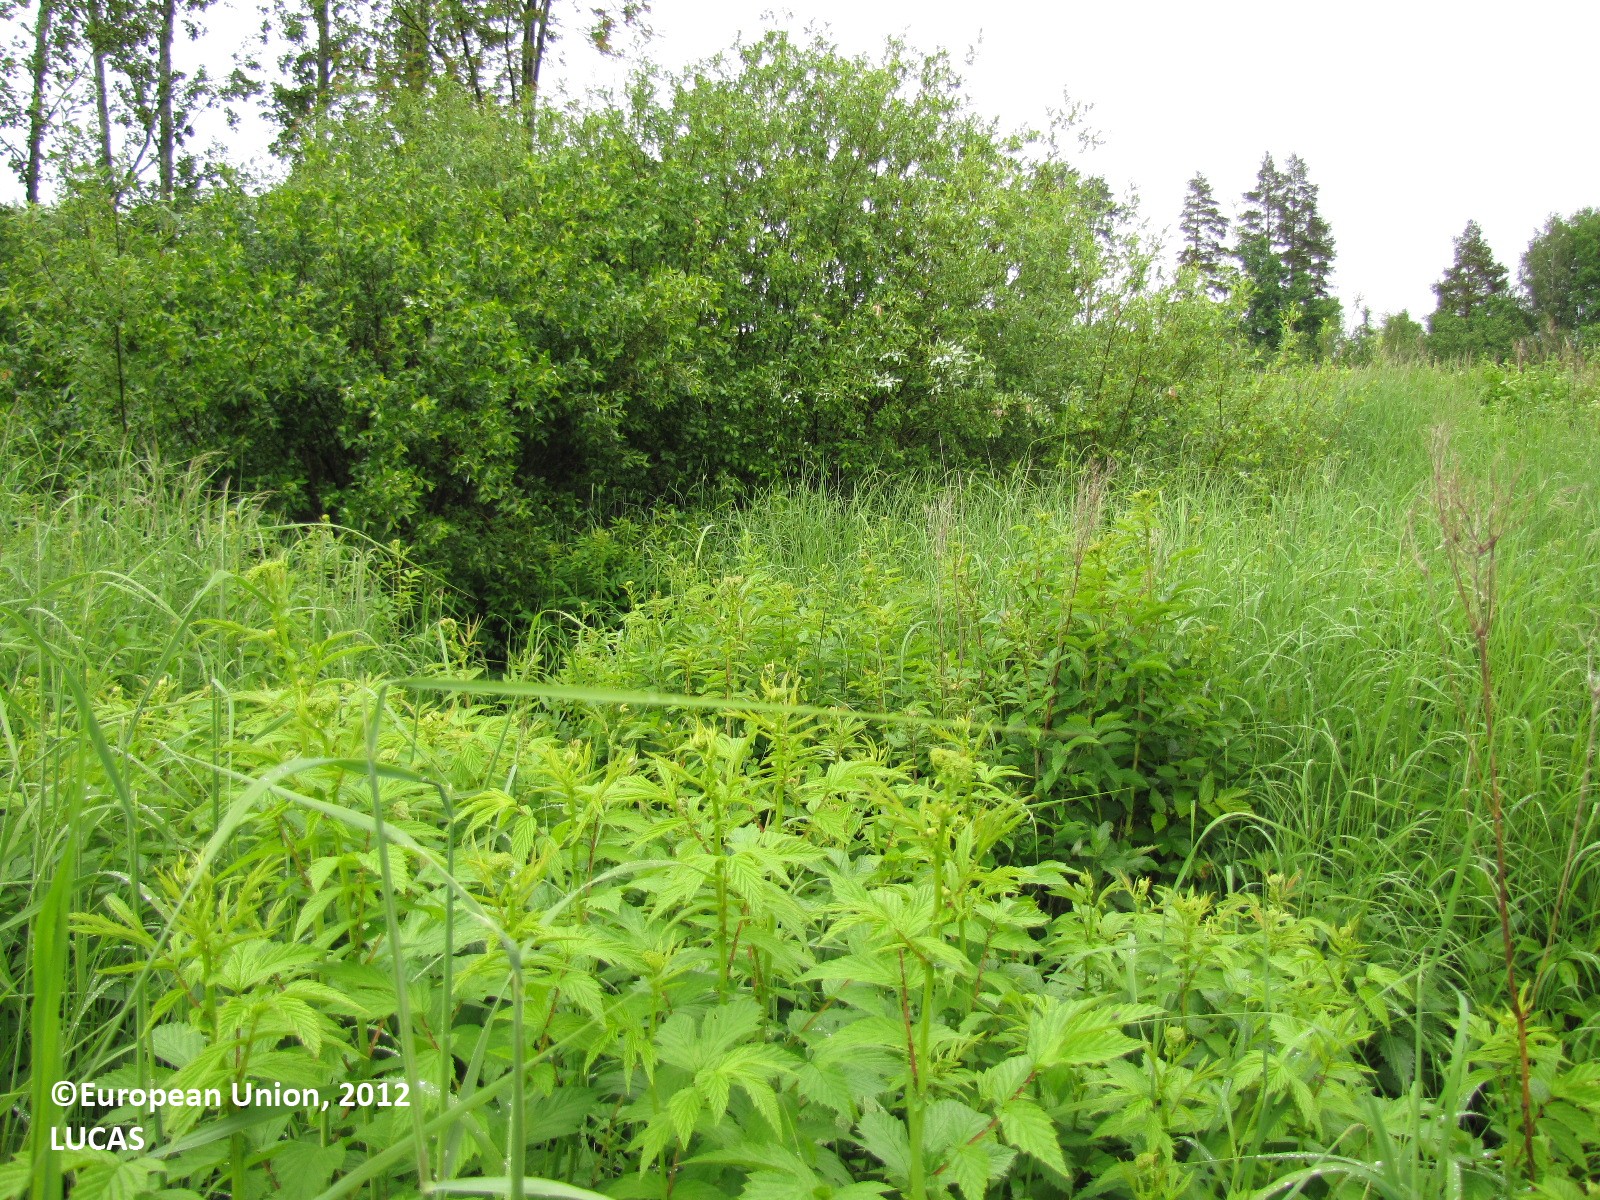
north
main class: Shrubland
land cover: Shrubland with sparse tree cover
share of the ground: 25 - 50 %
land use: Agriculture (excluding fallow land and kitchen gardens)
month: June
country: FI
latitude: 61.2964
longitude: 24.3382
